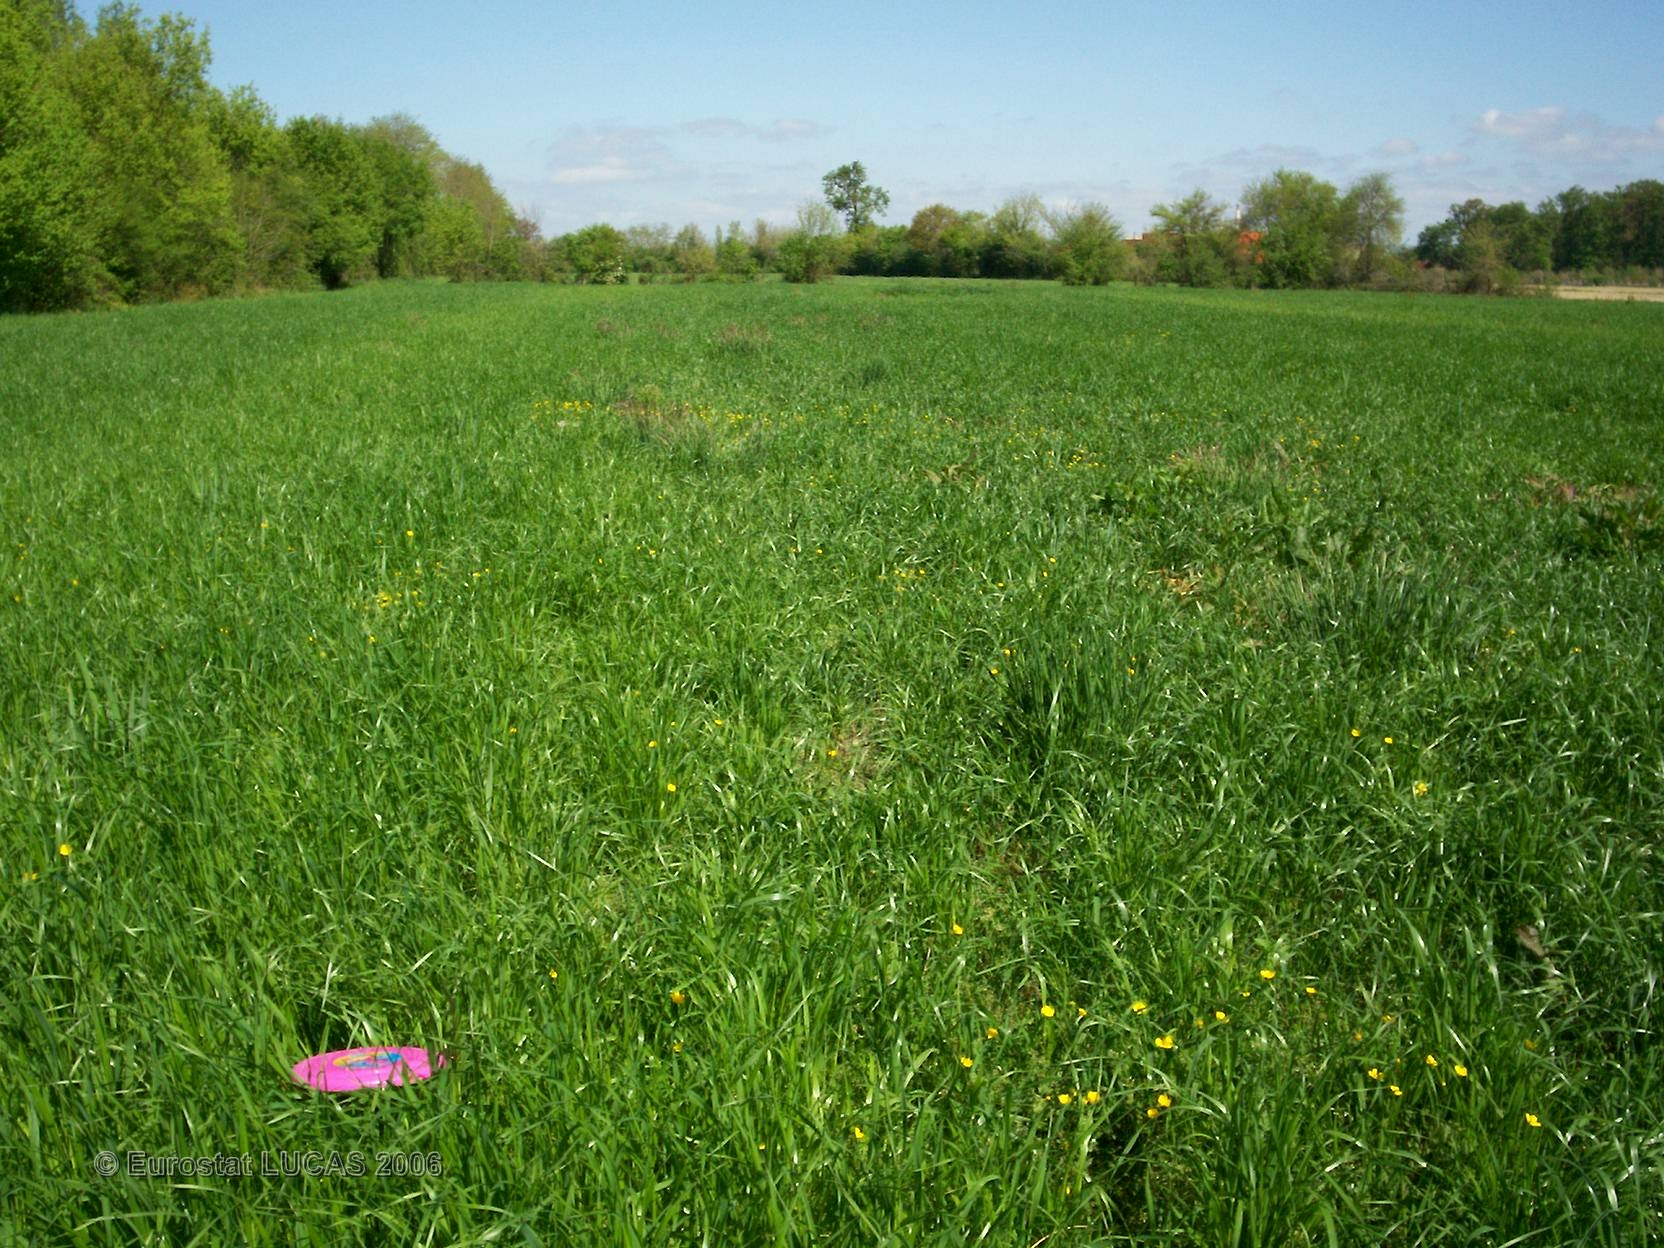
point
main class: Grassland
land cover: Grassland without tree/shrub cover
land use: Agriculture (excluding fallow land and kitchen gardens)
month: April
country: FR
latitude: 43.3840
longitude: -0.6376
